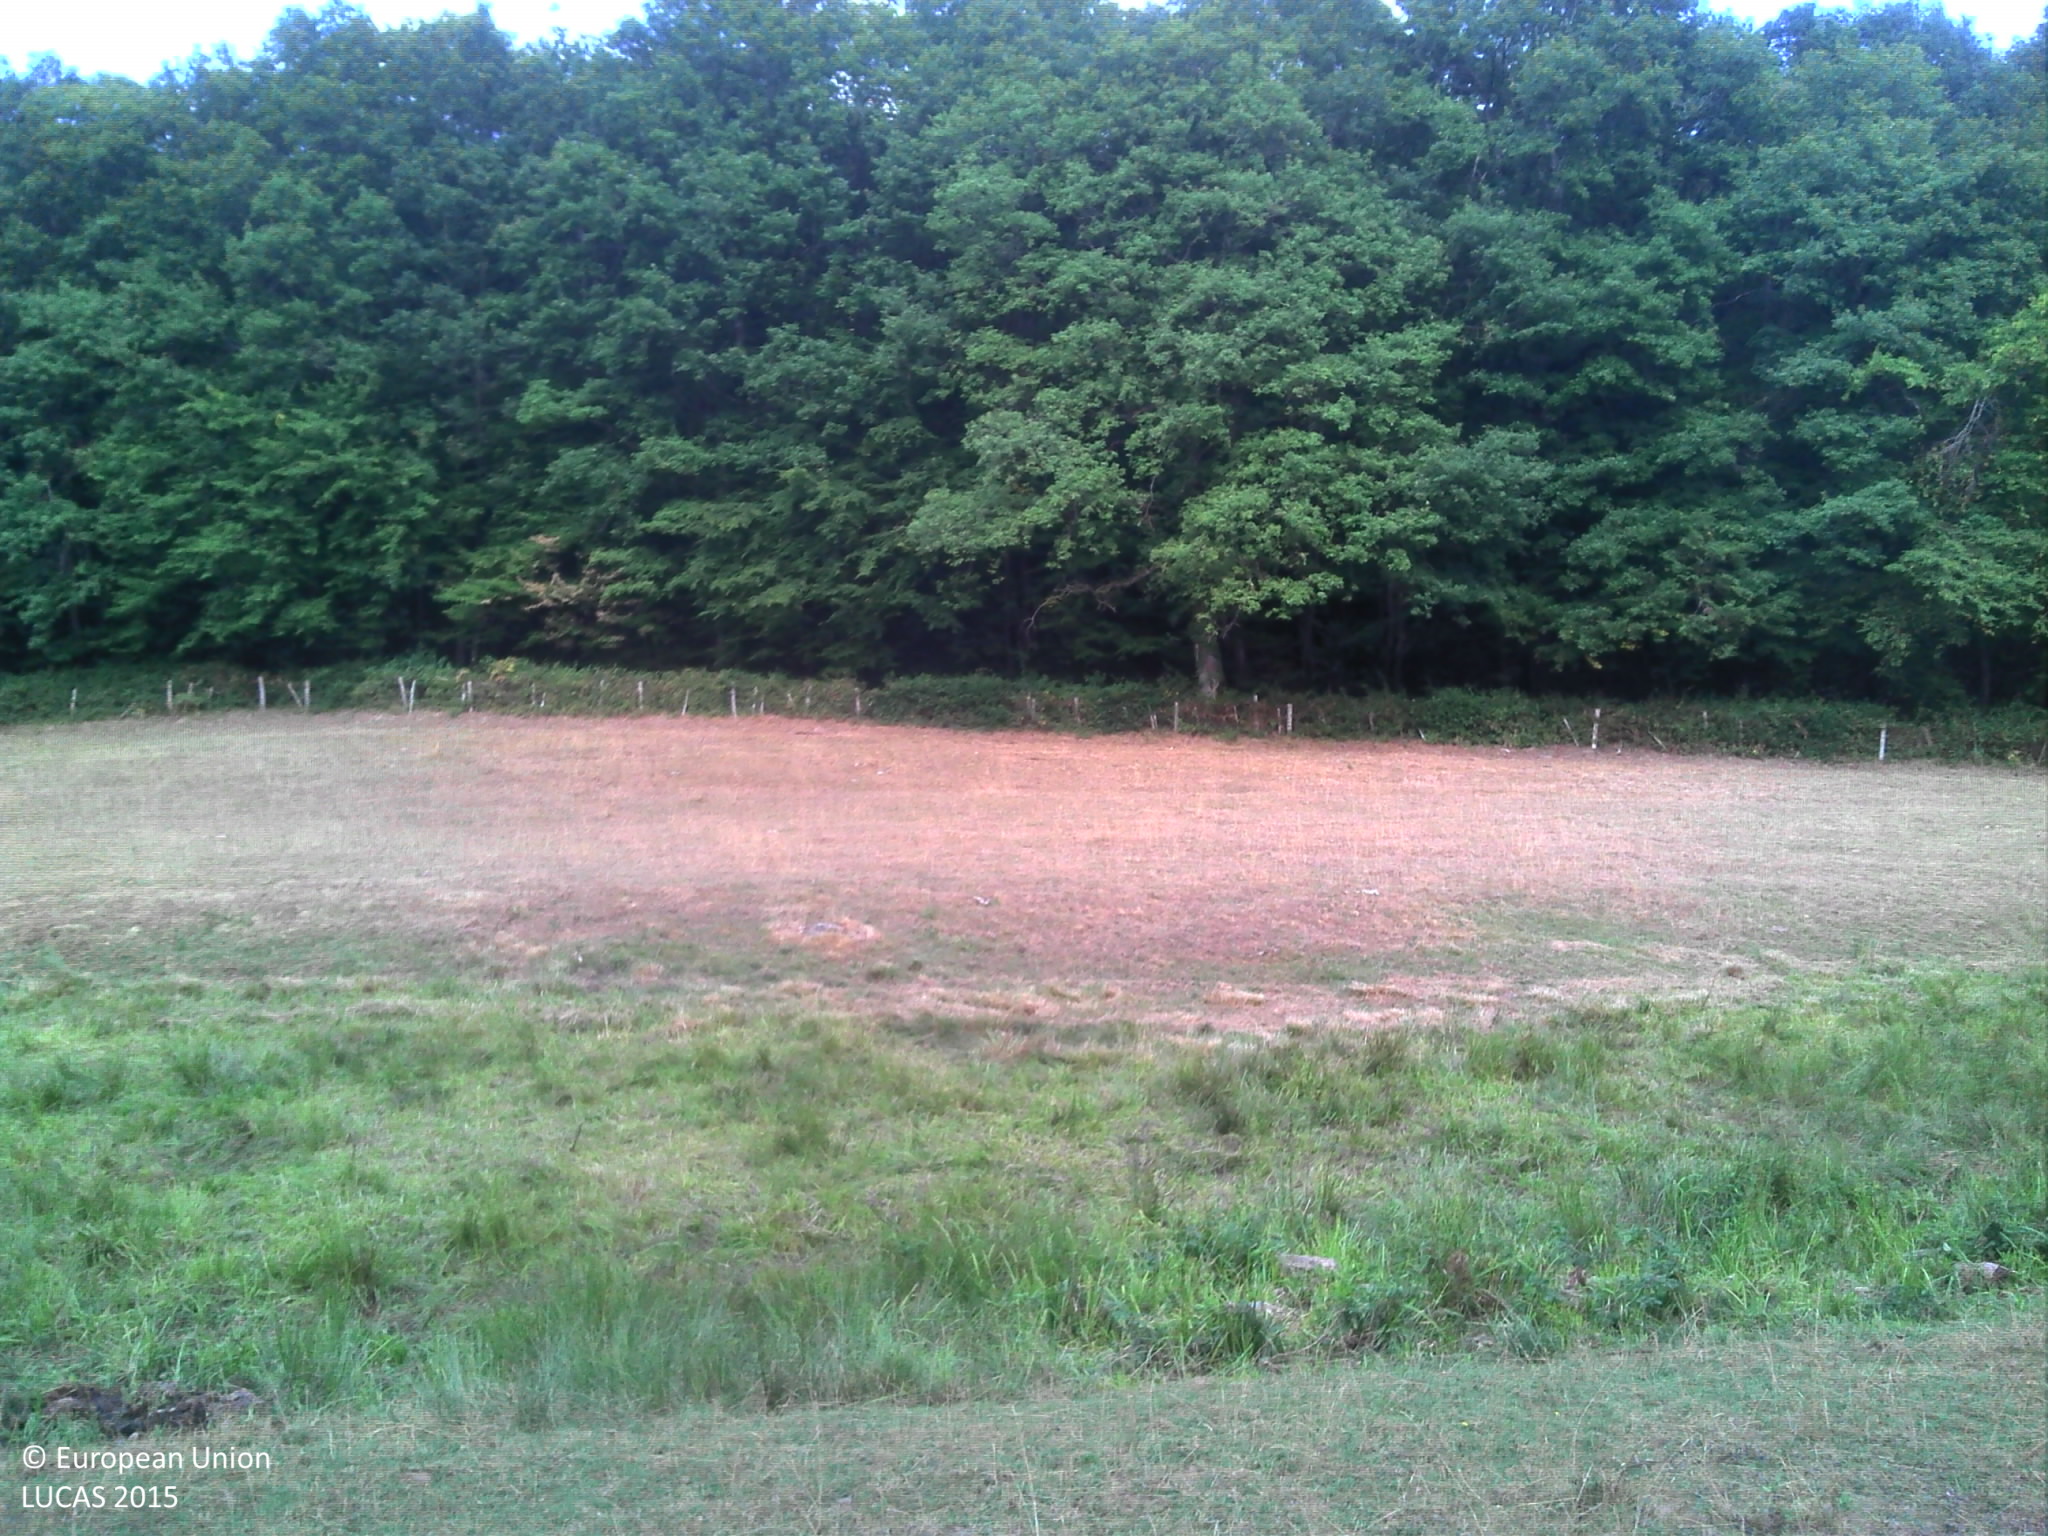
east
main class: Grassland
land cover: Grassland without tree/shrub cover
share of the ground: > 75 %
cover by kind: herbaceous plants 100 %
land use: Agriculture (excluding fallow land and kitchen gardens)
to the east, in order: Grassland without tree/shrub cover; Rivers and streams; Grassland without tree/shrub cover; Fences; Broadleaved woodland
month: August
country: FR
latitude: 46.6582
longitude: 4.4469
